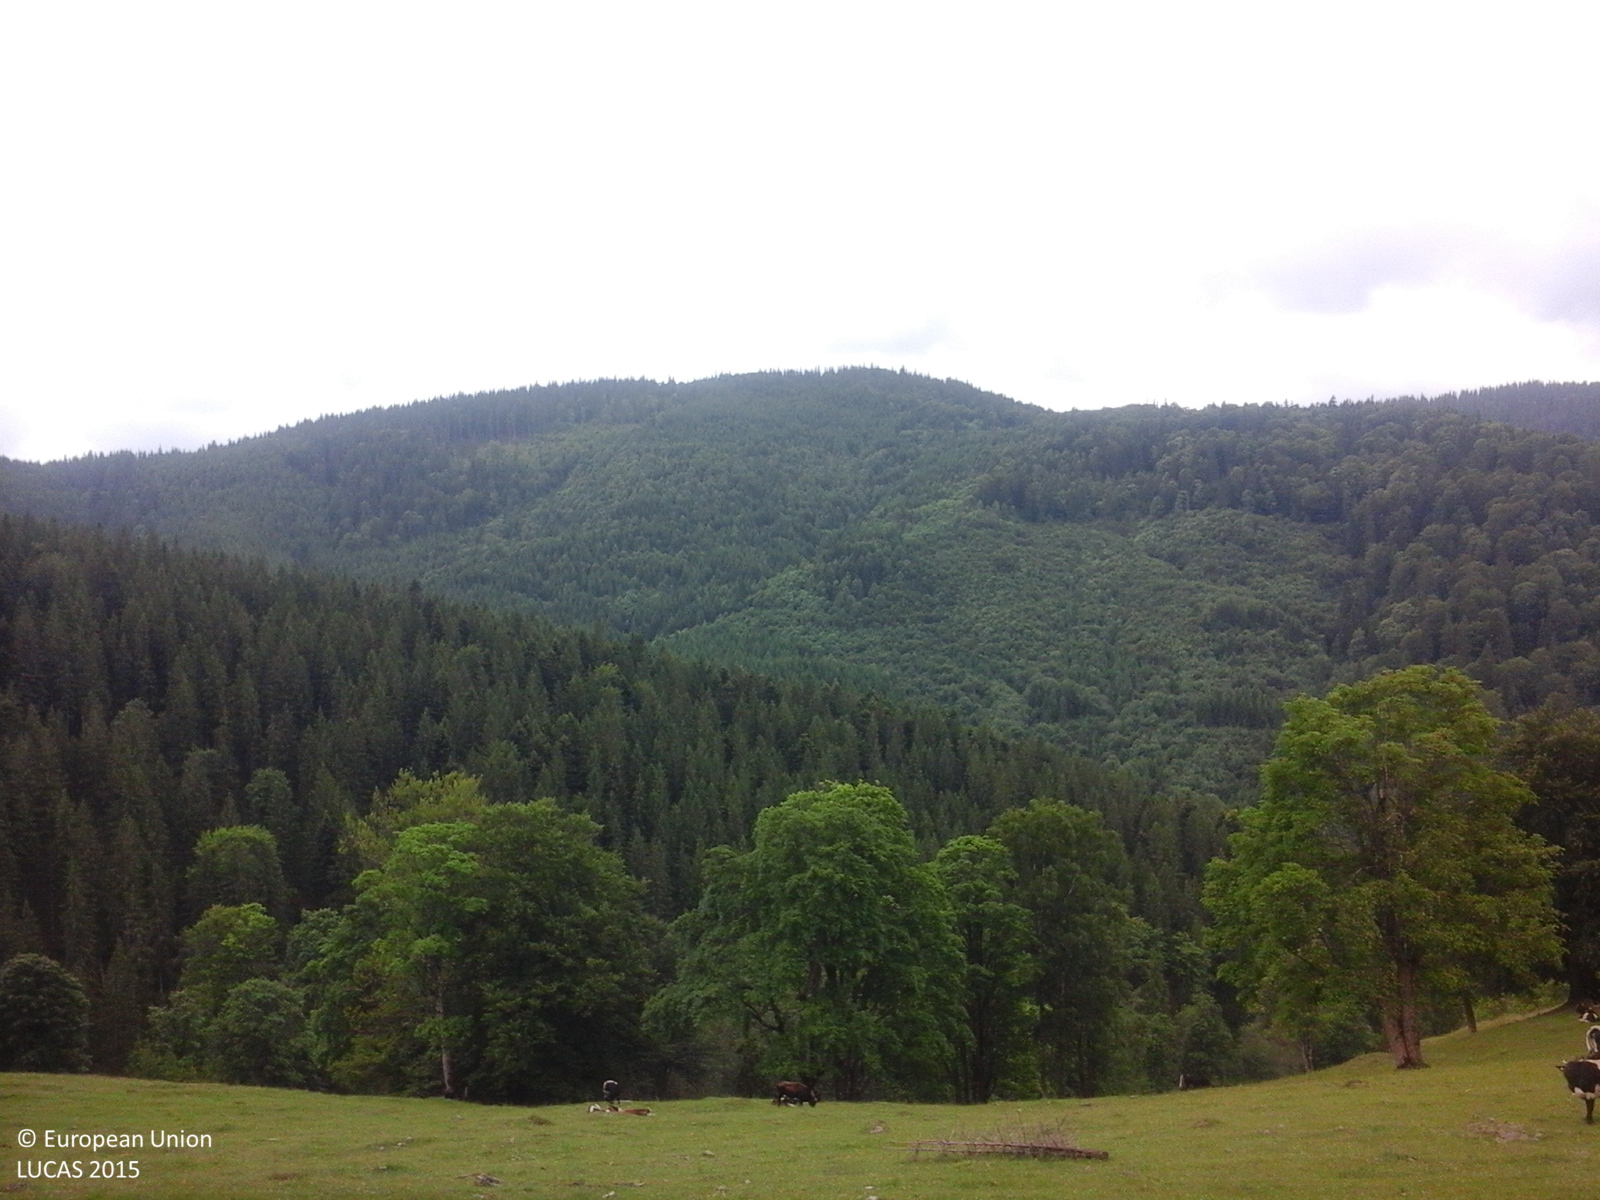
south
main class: Grassland
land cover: Grassland without tree/shrub cover
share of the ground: > 75 %
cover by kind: herbaceous plants 100 %
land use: Agriculture (excluding fallow land and kitchen gardens)
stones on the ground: 10 - 25 %
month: June
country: RO
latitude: 47.3323
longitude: 25.6681
